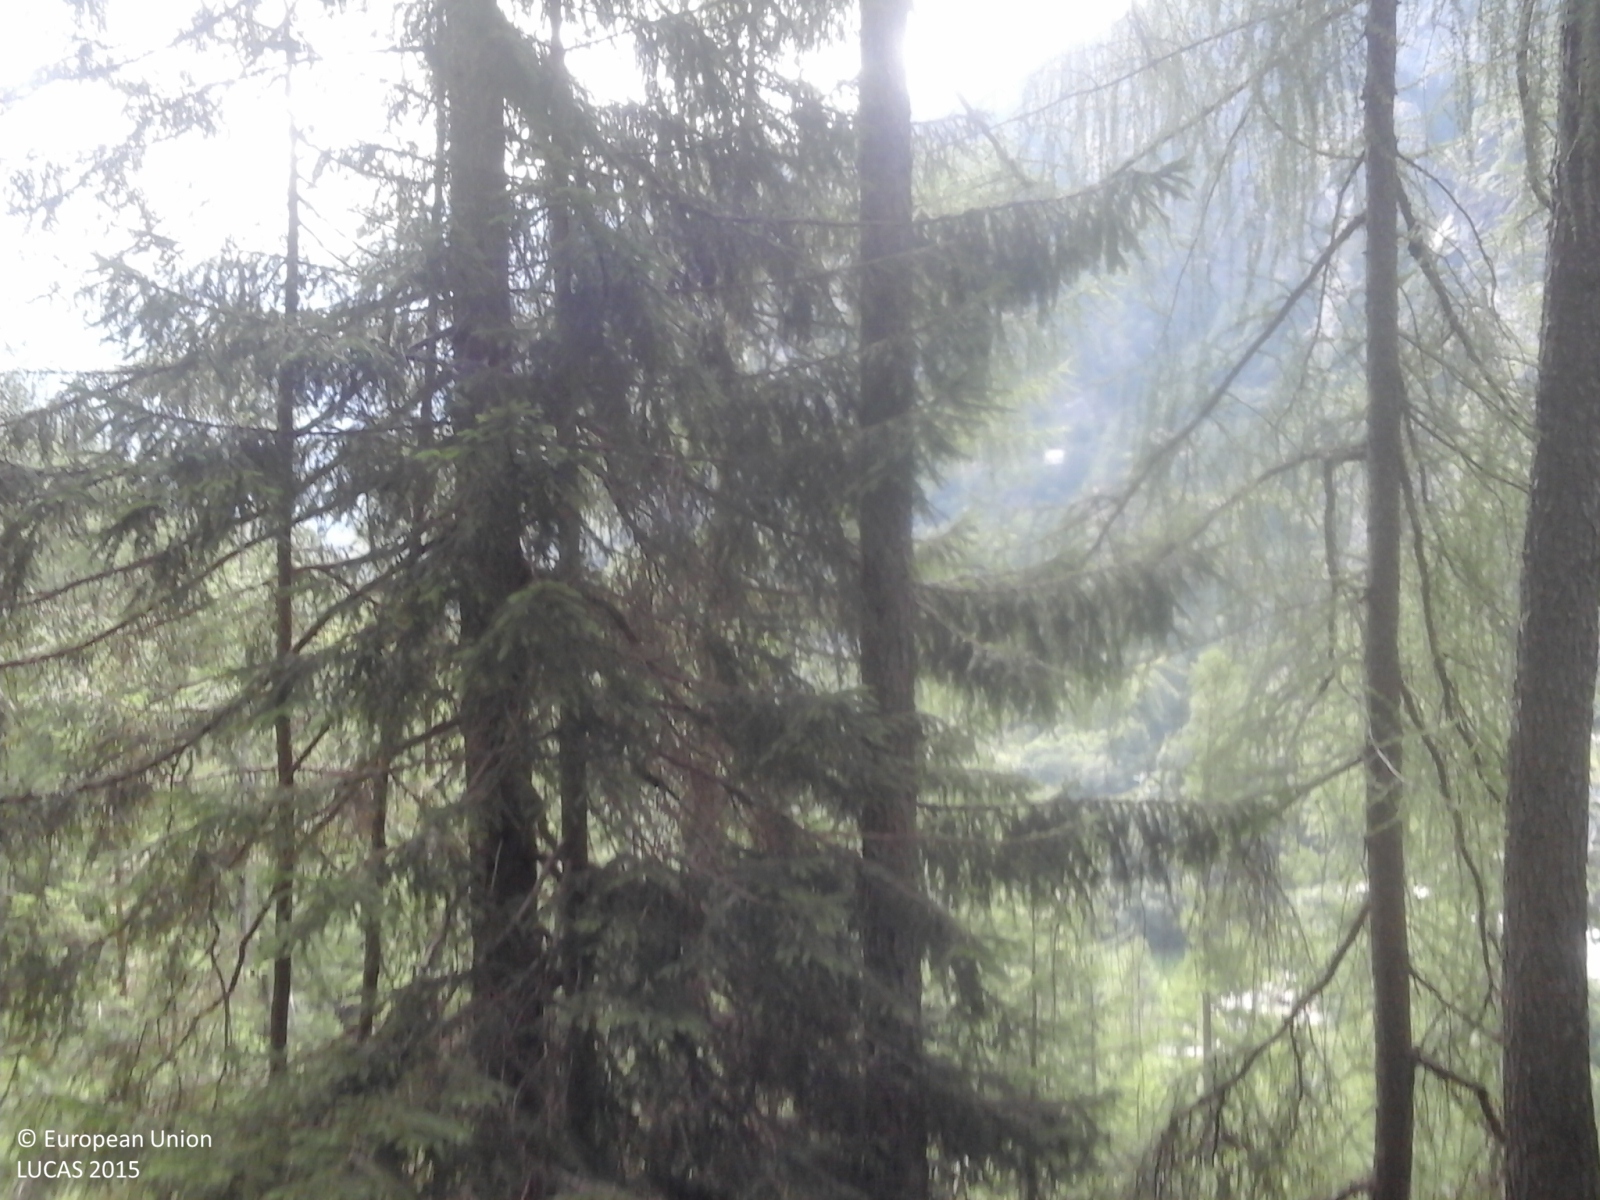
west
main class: Woodland
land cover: Spruce dominated coniferous woodland
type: alpine coniferous forest
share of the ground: > 75 %
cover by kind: coniferous forest trees 100 %
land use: Semi-natural and natural areas not in use
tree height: > 5 m
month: July
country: IT
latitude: 46.2791
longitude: 9.9093
